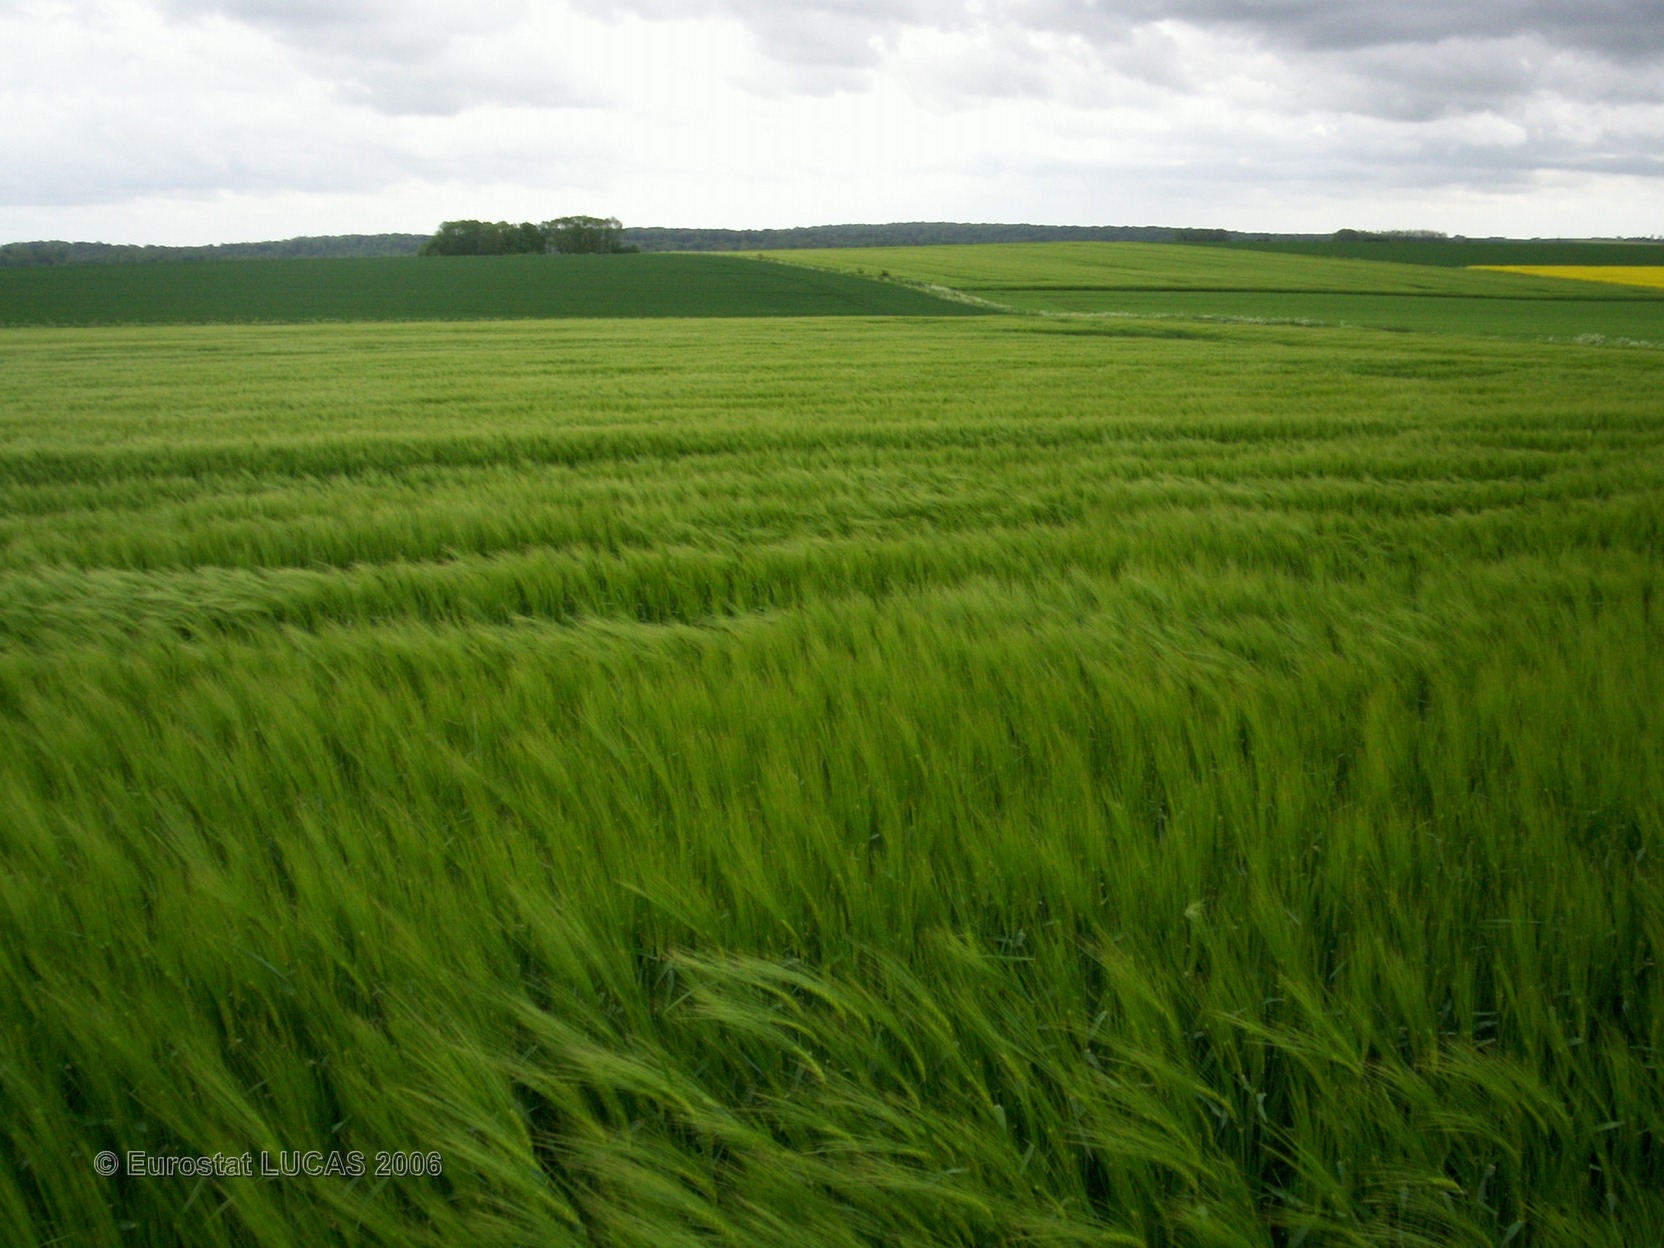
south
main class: Cropland
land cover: Barley
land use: Agriculture (excluding fallow land and kitchen gardens)
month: May
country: FR
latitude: 49.4244
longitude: 5.8493
